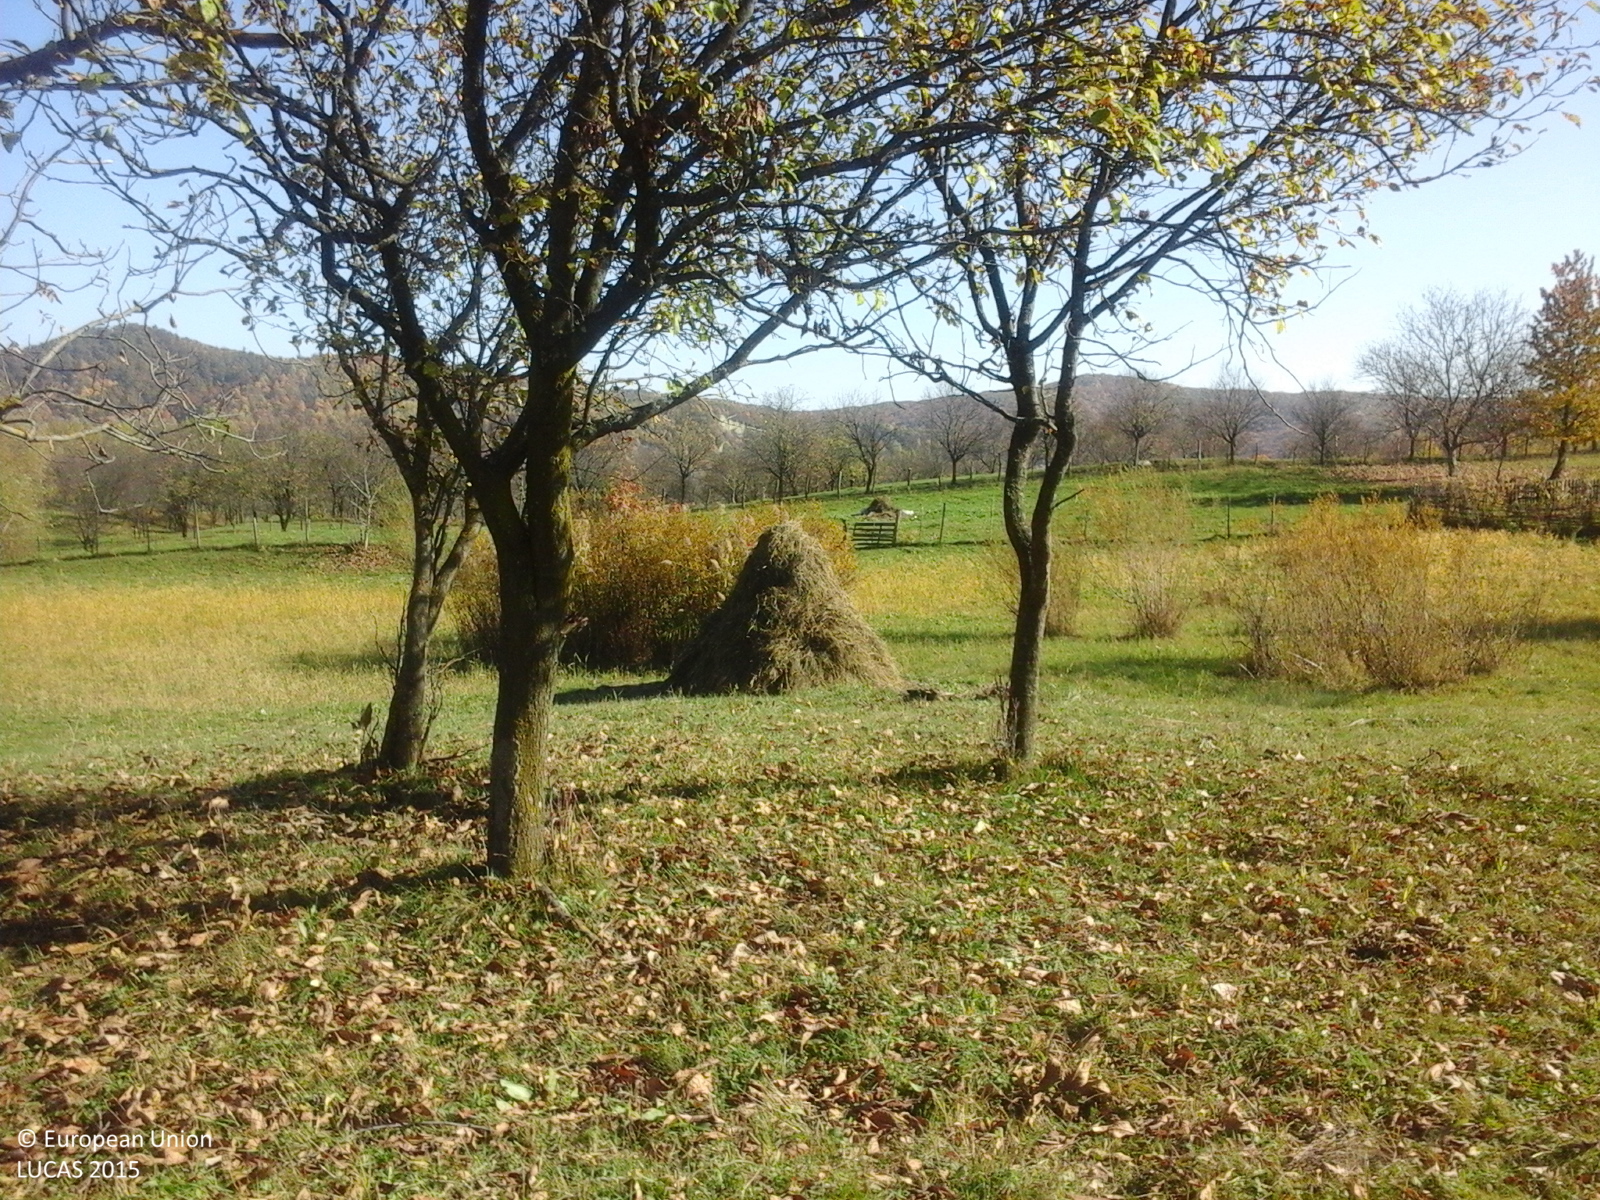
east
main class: Cropland
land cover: Other fruit trees and berries
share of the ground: 25 - 50 %
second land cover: Grassland without tree/shrub cover
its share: > 75 %
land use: Agriculture (excluding fallow land and kitchen gardens)
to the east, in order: Other fruit trees and berries; Grassland without tree/shrub cover; Grassland with sparse tree/shrub cover; Fences; Grassland without tree/shrub cover; Fences; Apple fruit; Grassland with sparse tree/shrub cover
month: October
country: RO
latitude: 45.4833
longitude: 26.8302
